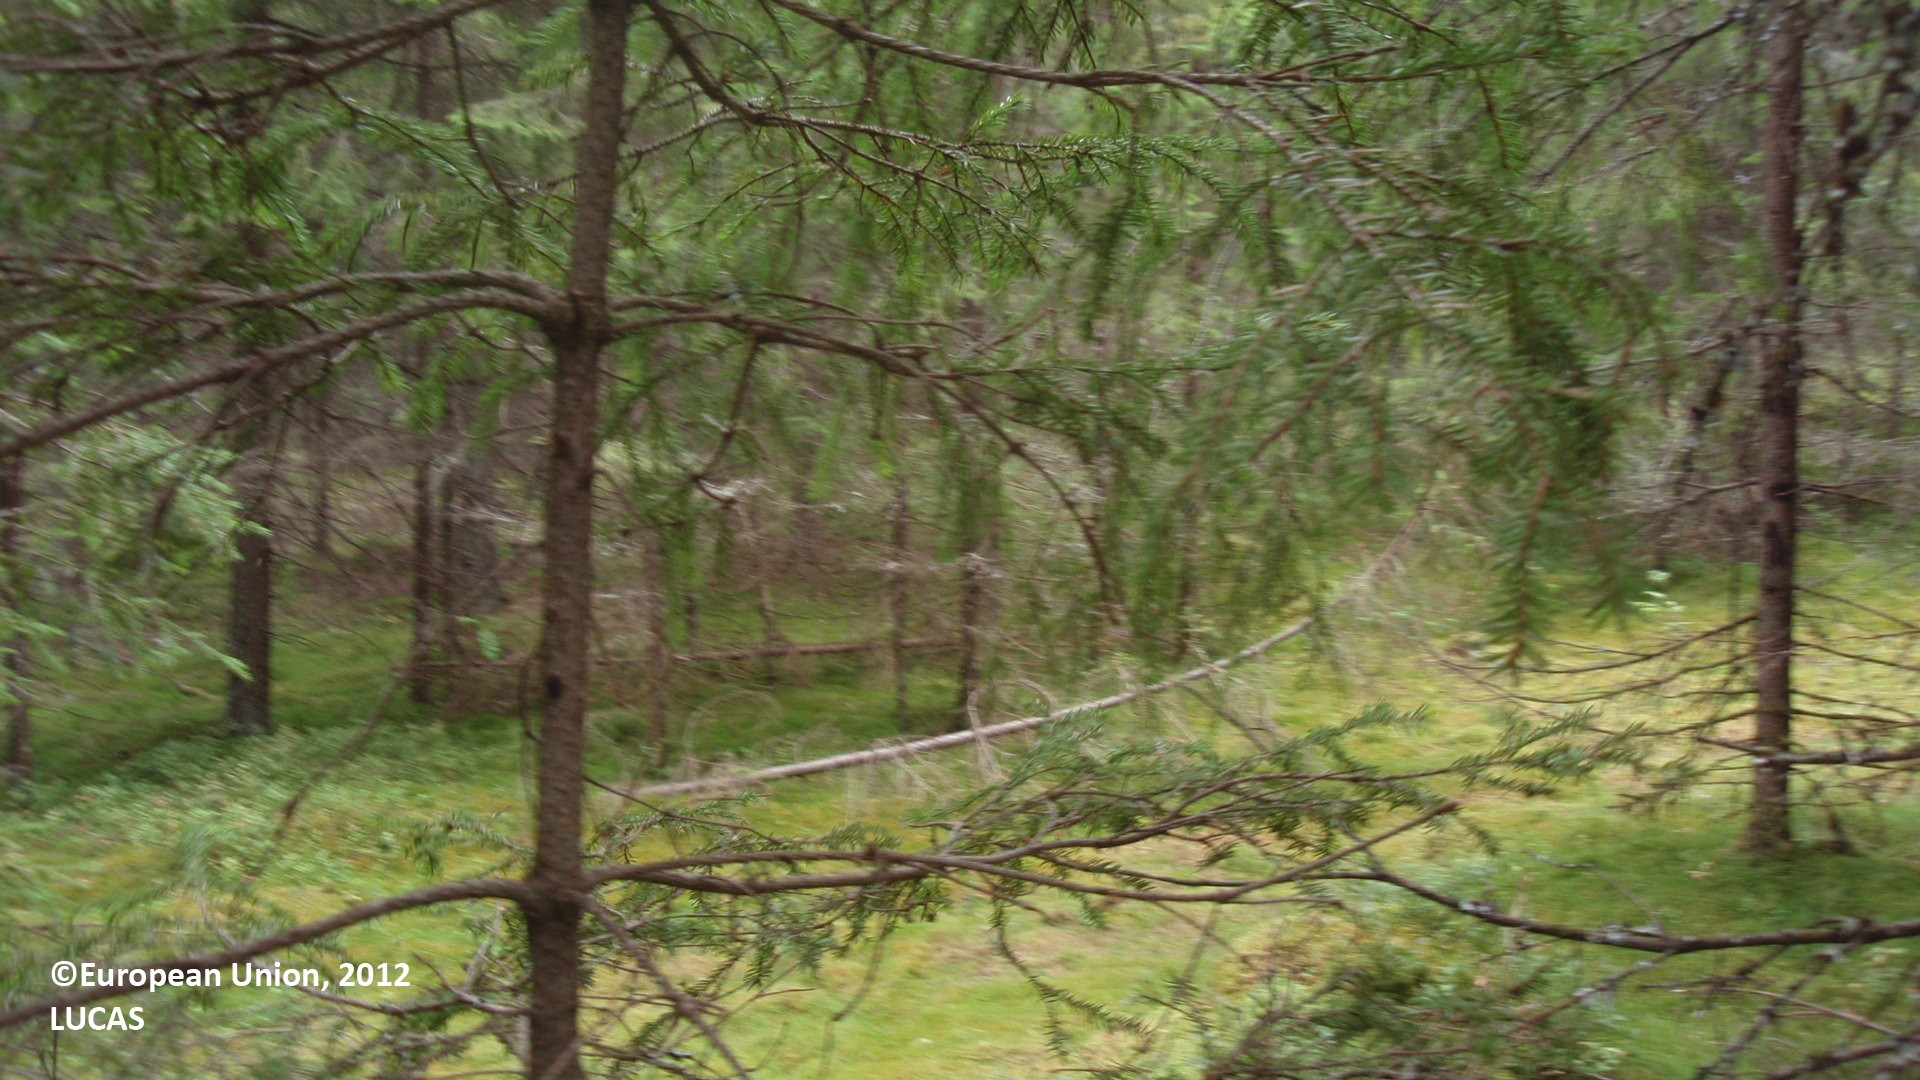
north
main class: Woodland
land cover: Spruce dominated coniferous woodland
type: boreal forest
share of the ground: 50 - 75 %
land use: Forestry
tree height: > 5 m
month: August
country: FI
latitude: 60.8160
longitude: 27.3313
